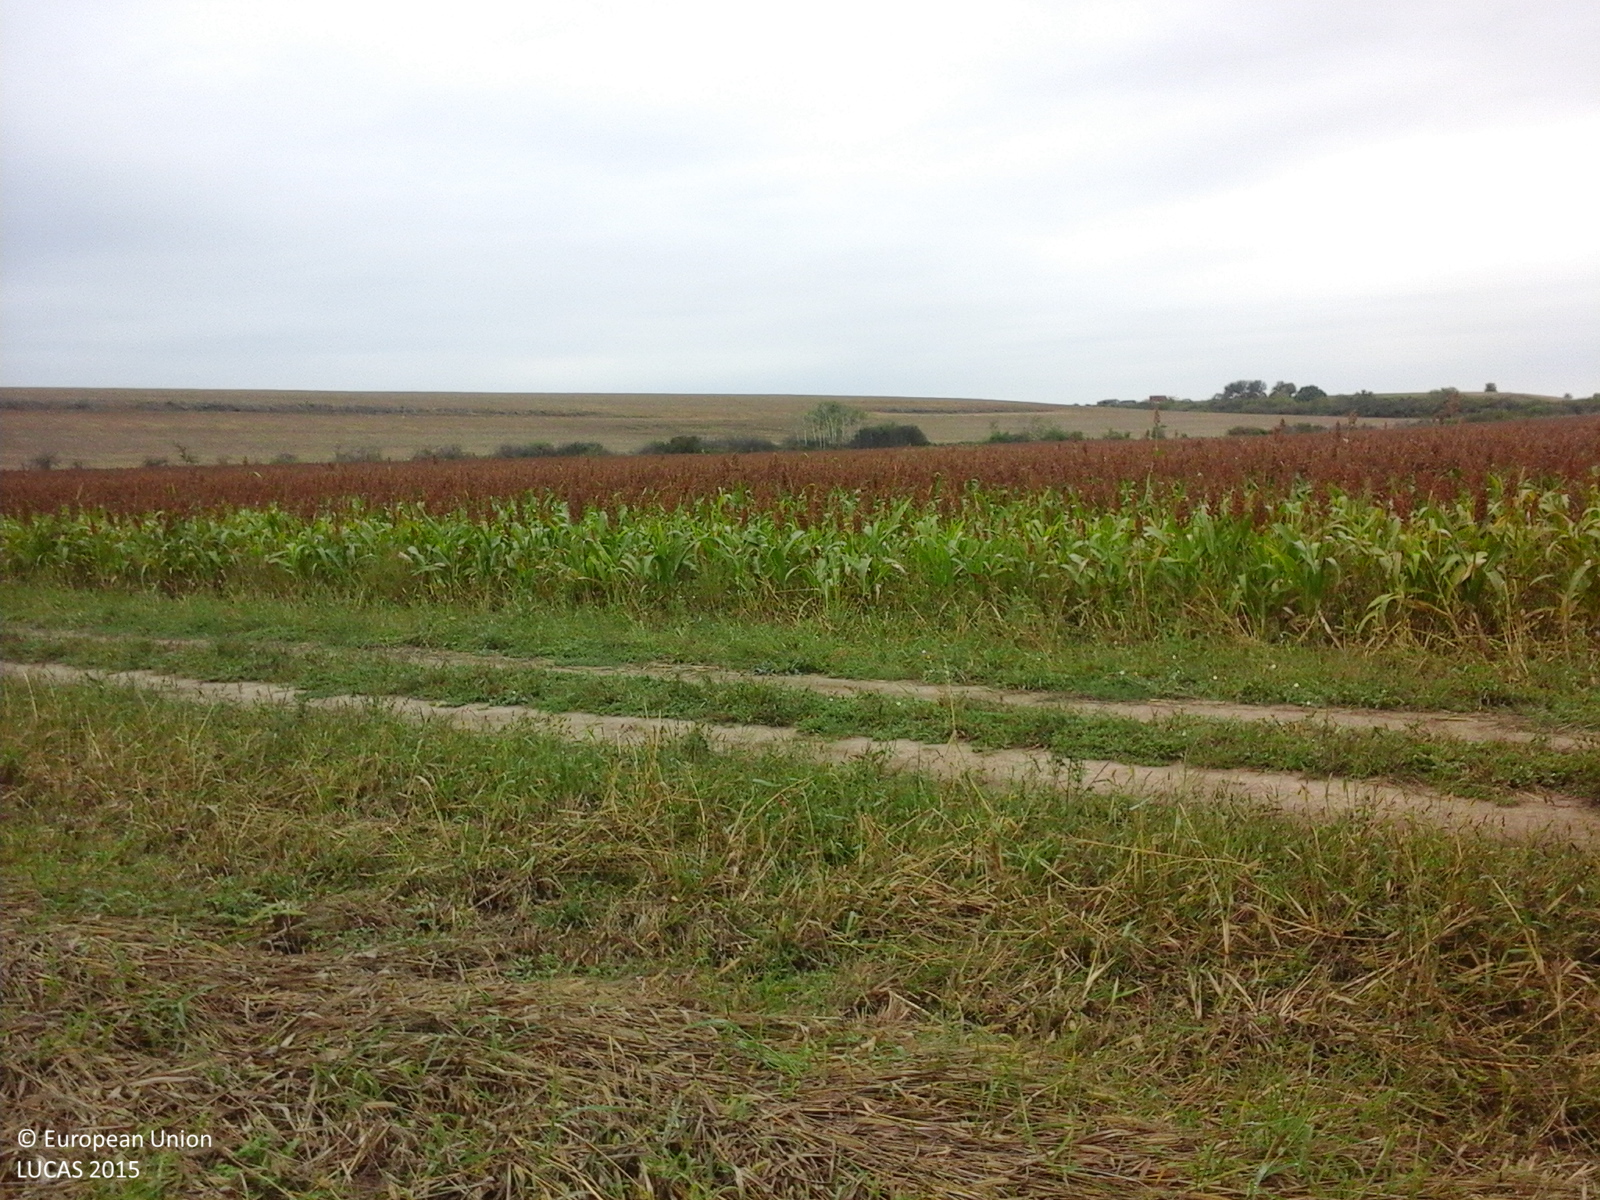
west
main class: Cropland
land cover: Other cereals
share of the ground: > 75 %
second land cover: Spontaneously vegetated surfaces
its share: 25 - 50 %
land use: Agriculture (excluding fallow land and kitchen gardens)
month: September
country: RO
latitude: 45.5942
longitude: 22.0512
